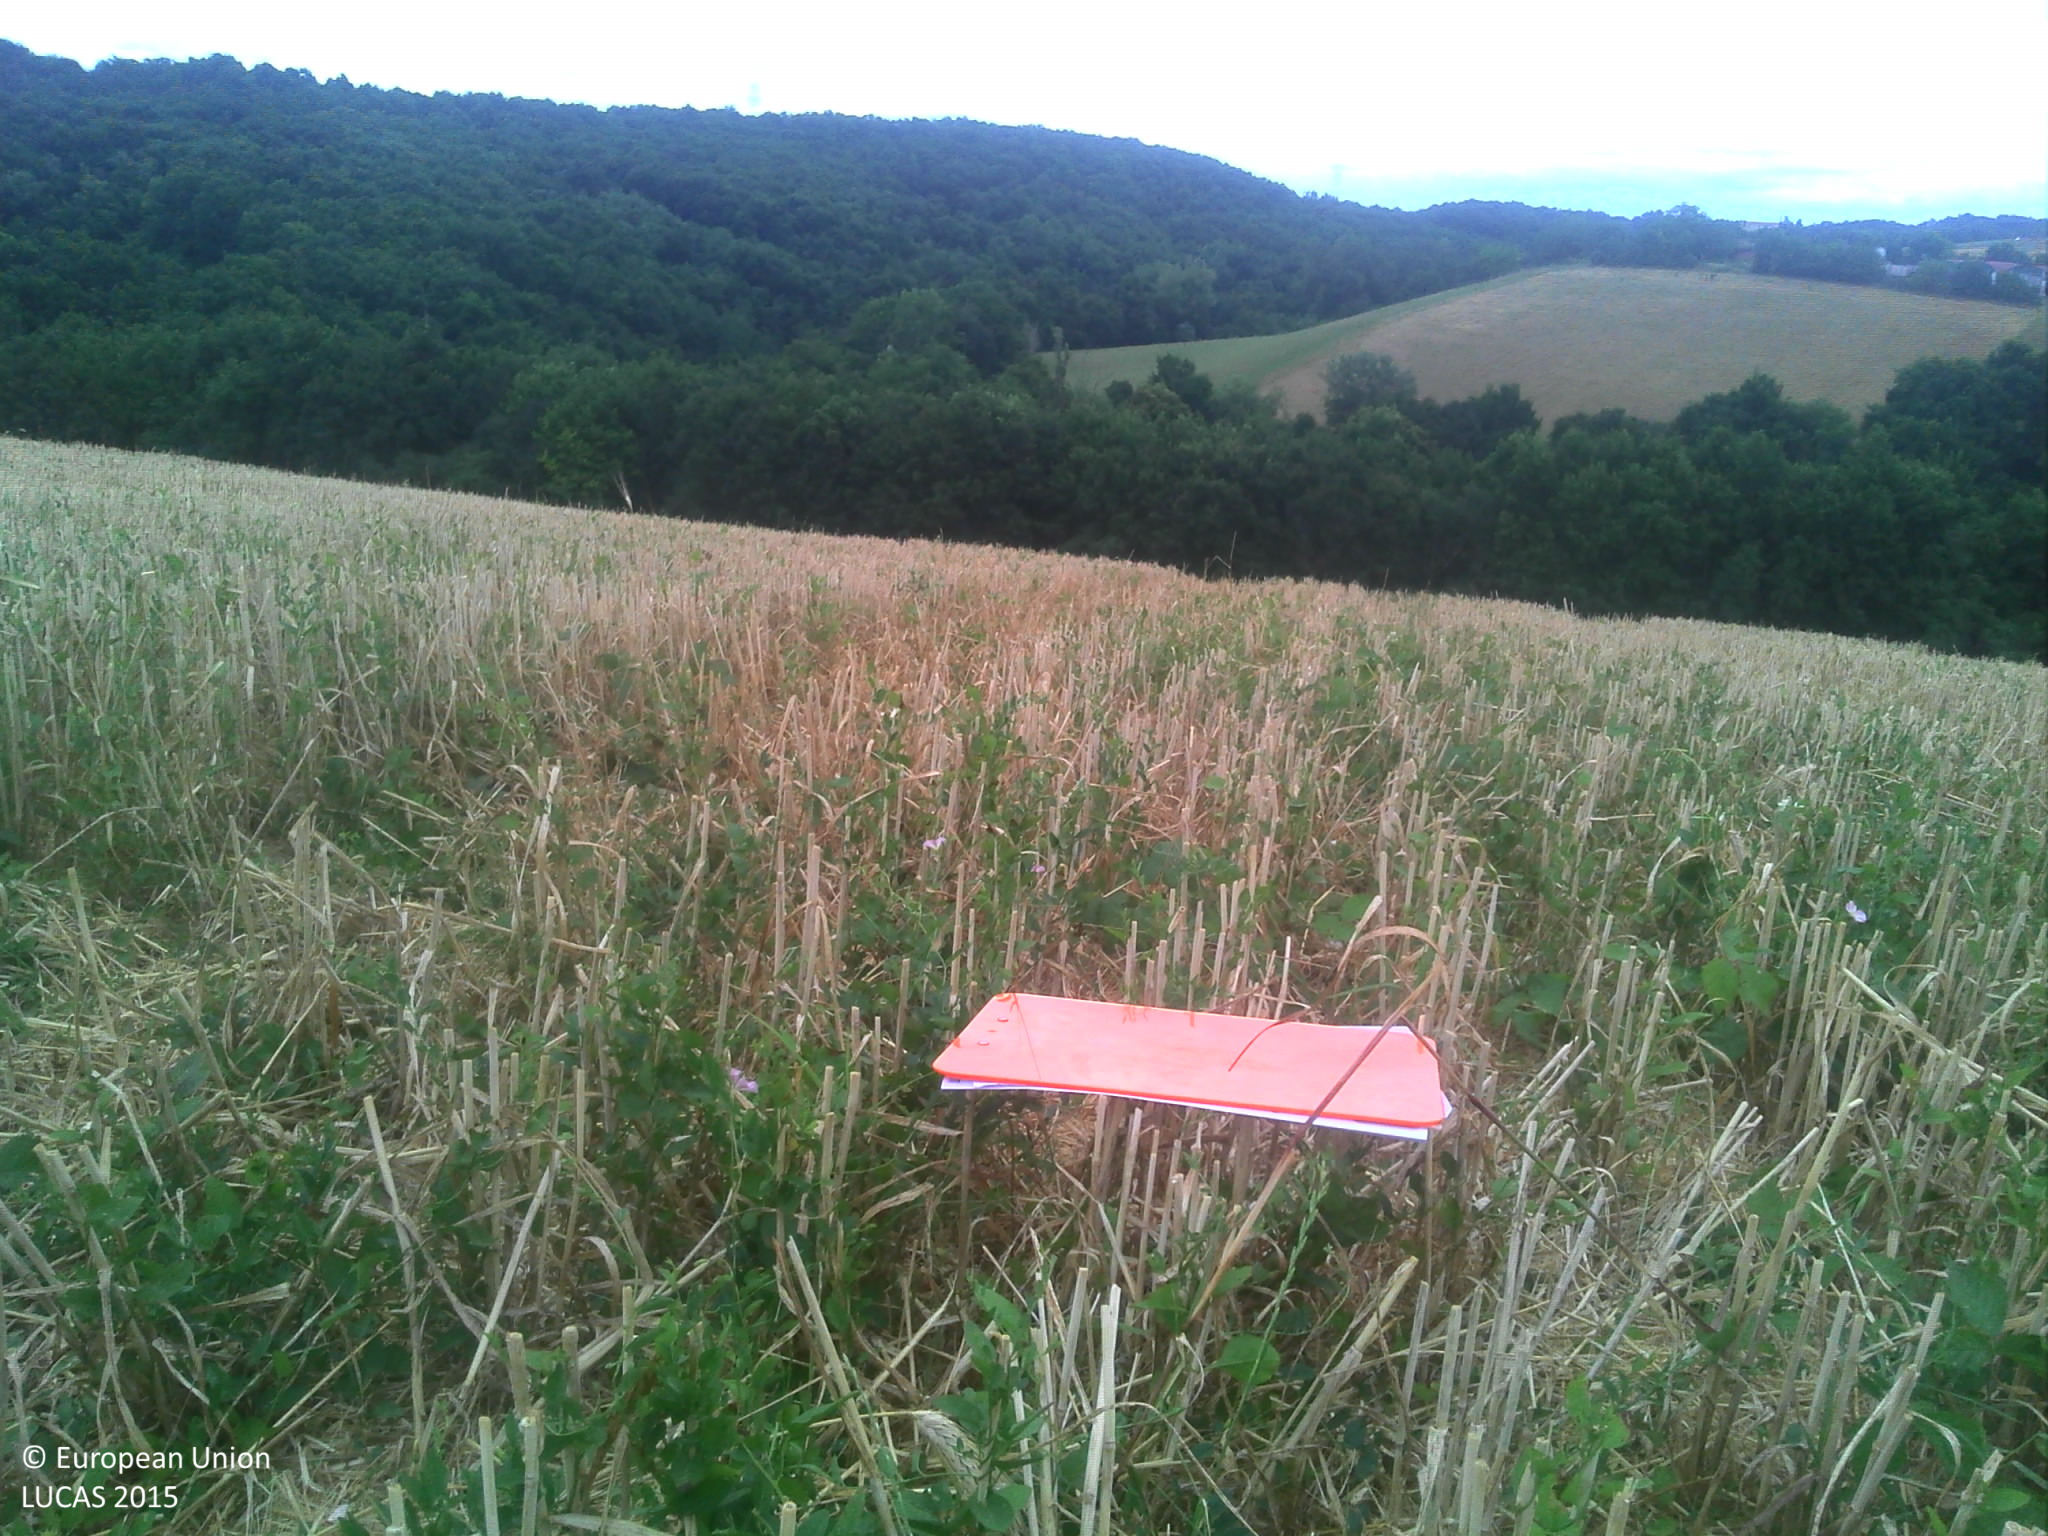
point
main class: Cropland
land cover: Common wheat
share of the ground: > 75 %
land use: Agriculture (excluding fallow land and kitchen gardens)
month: July
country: FR
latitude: 43.3049
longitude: 1.4116
